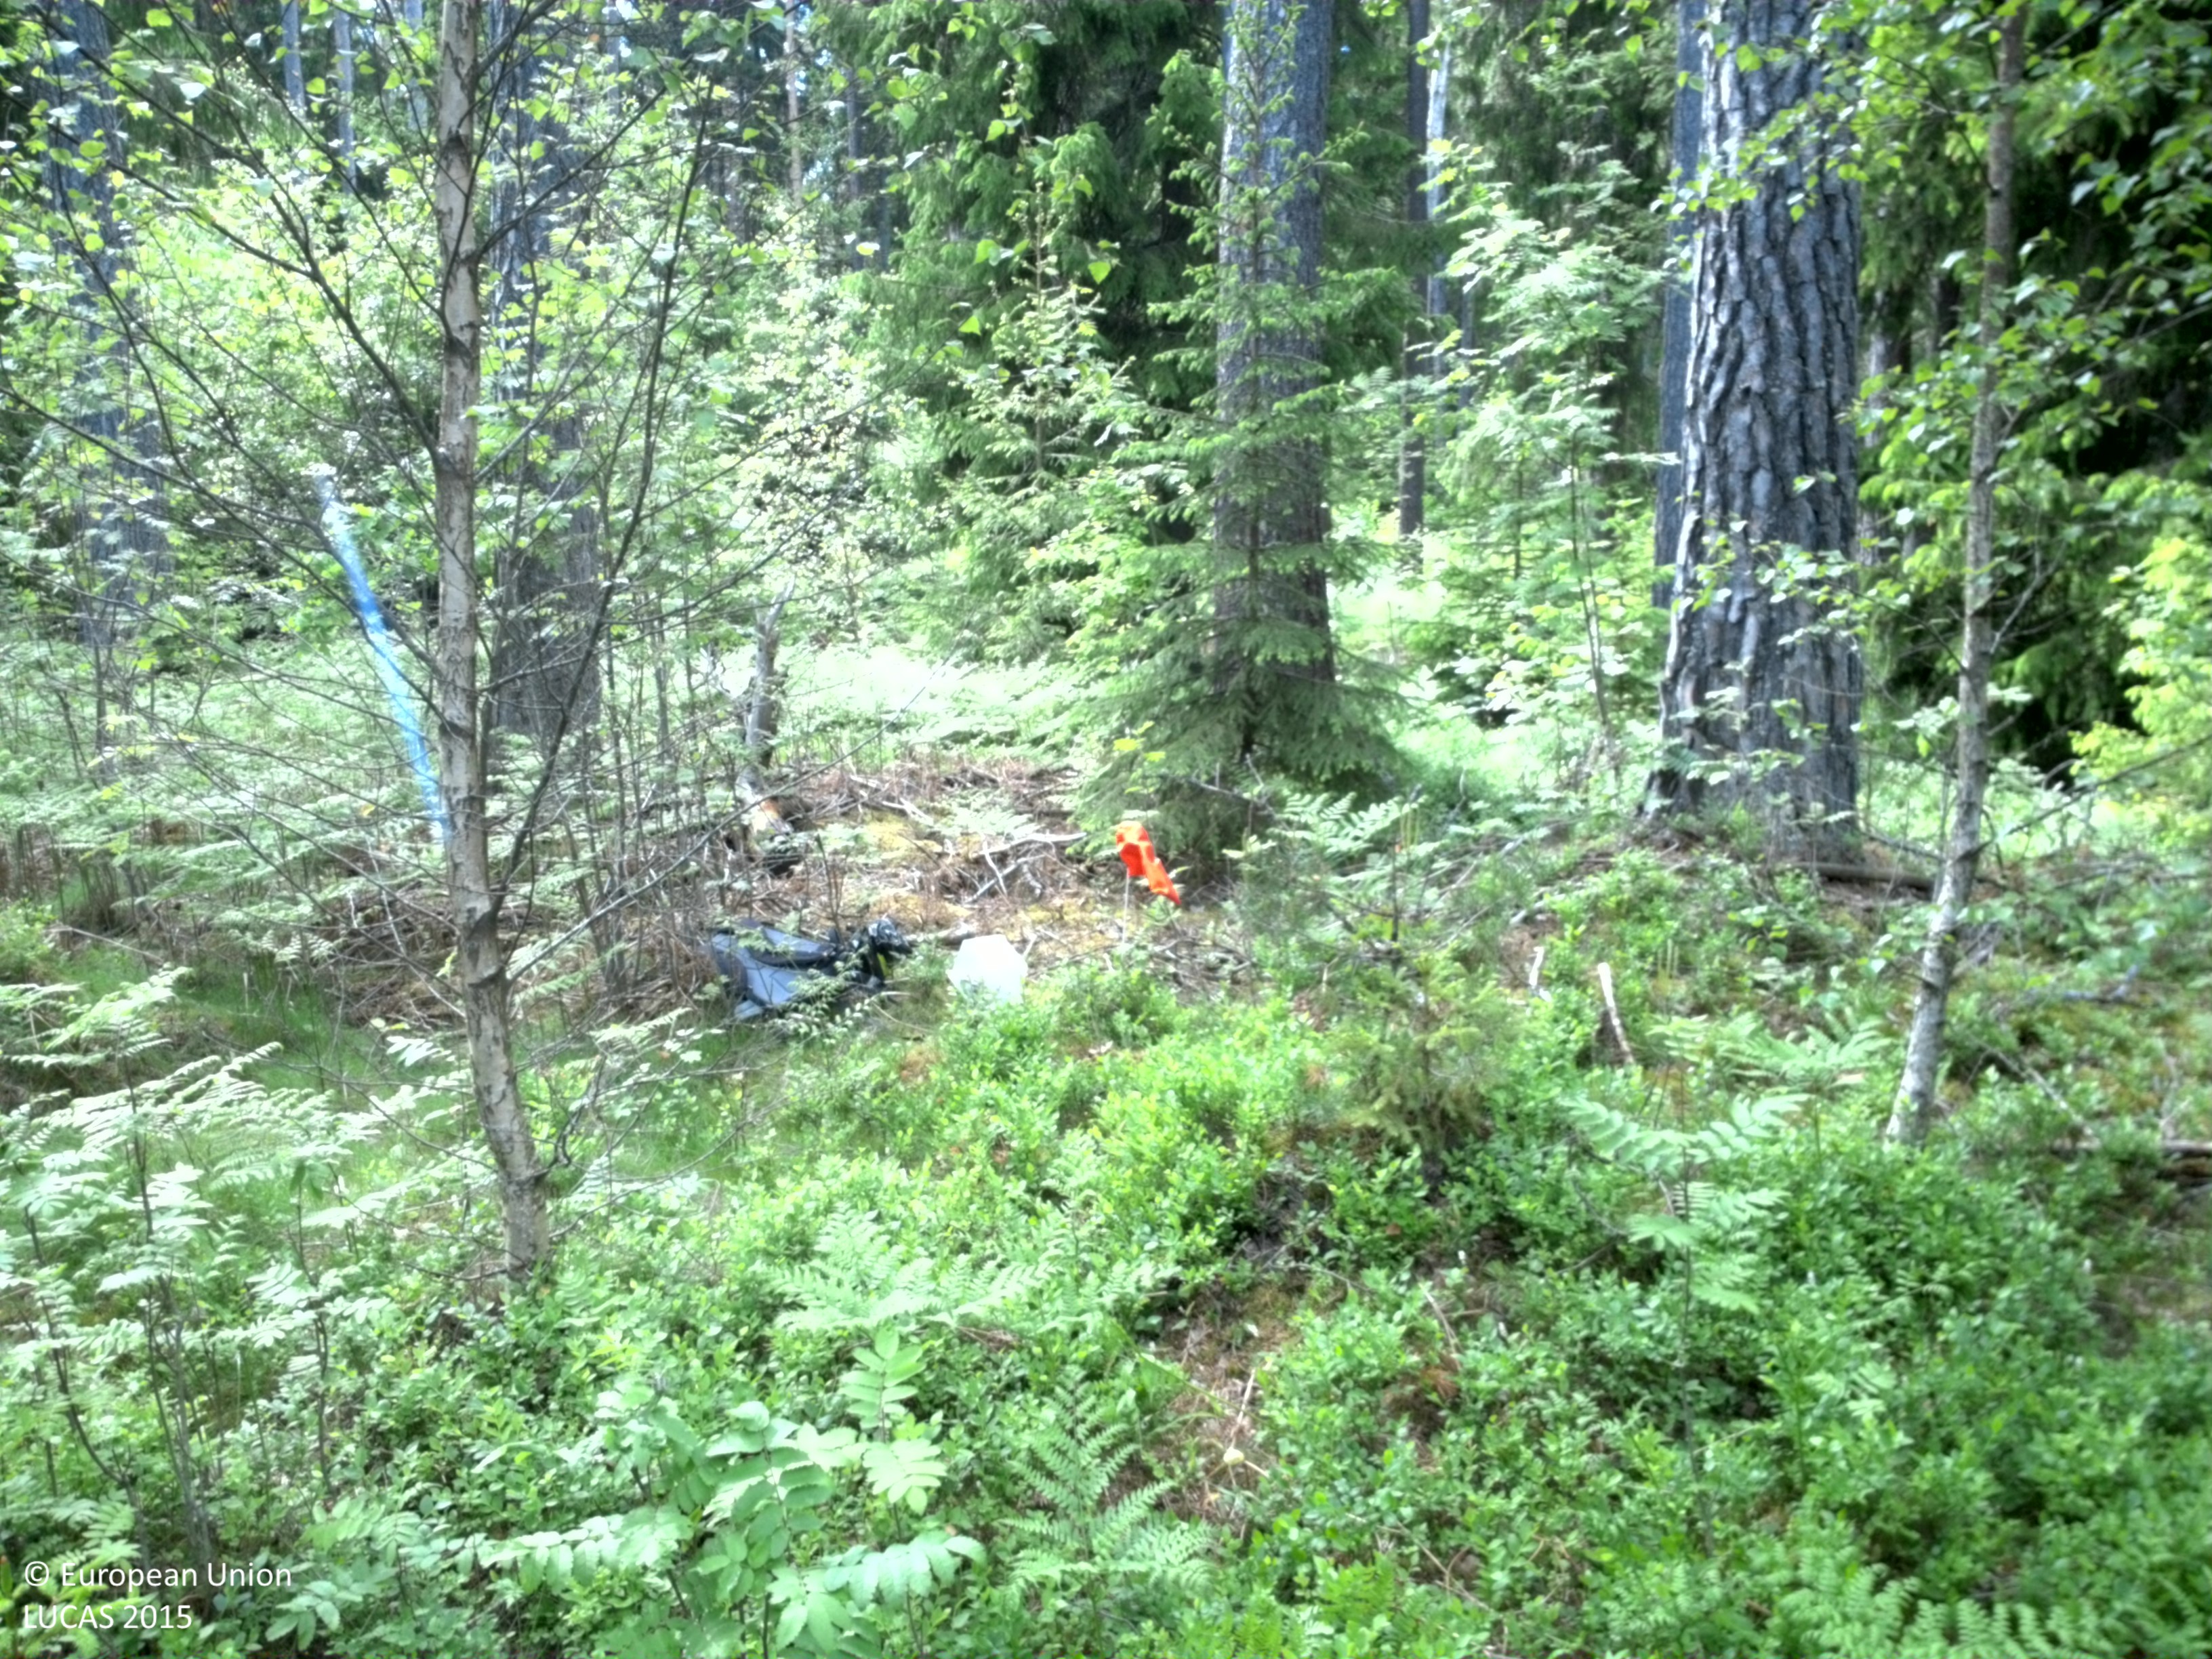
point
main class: Woodland
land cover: Pine dominated coniferous woodland
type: boreal forest
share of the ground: 10 - 25 %
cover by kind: herbaceous plants 45 %, lichens and mosses 30 %, coniferous forest trees 20 %, broadleaved forest trees 5 %
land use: Forestry
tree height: > 5 m
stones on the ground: < 10 %
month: June
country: SE
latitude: 58.5118
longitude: 15.2979
